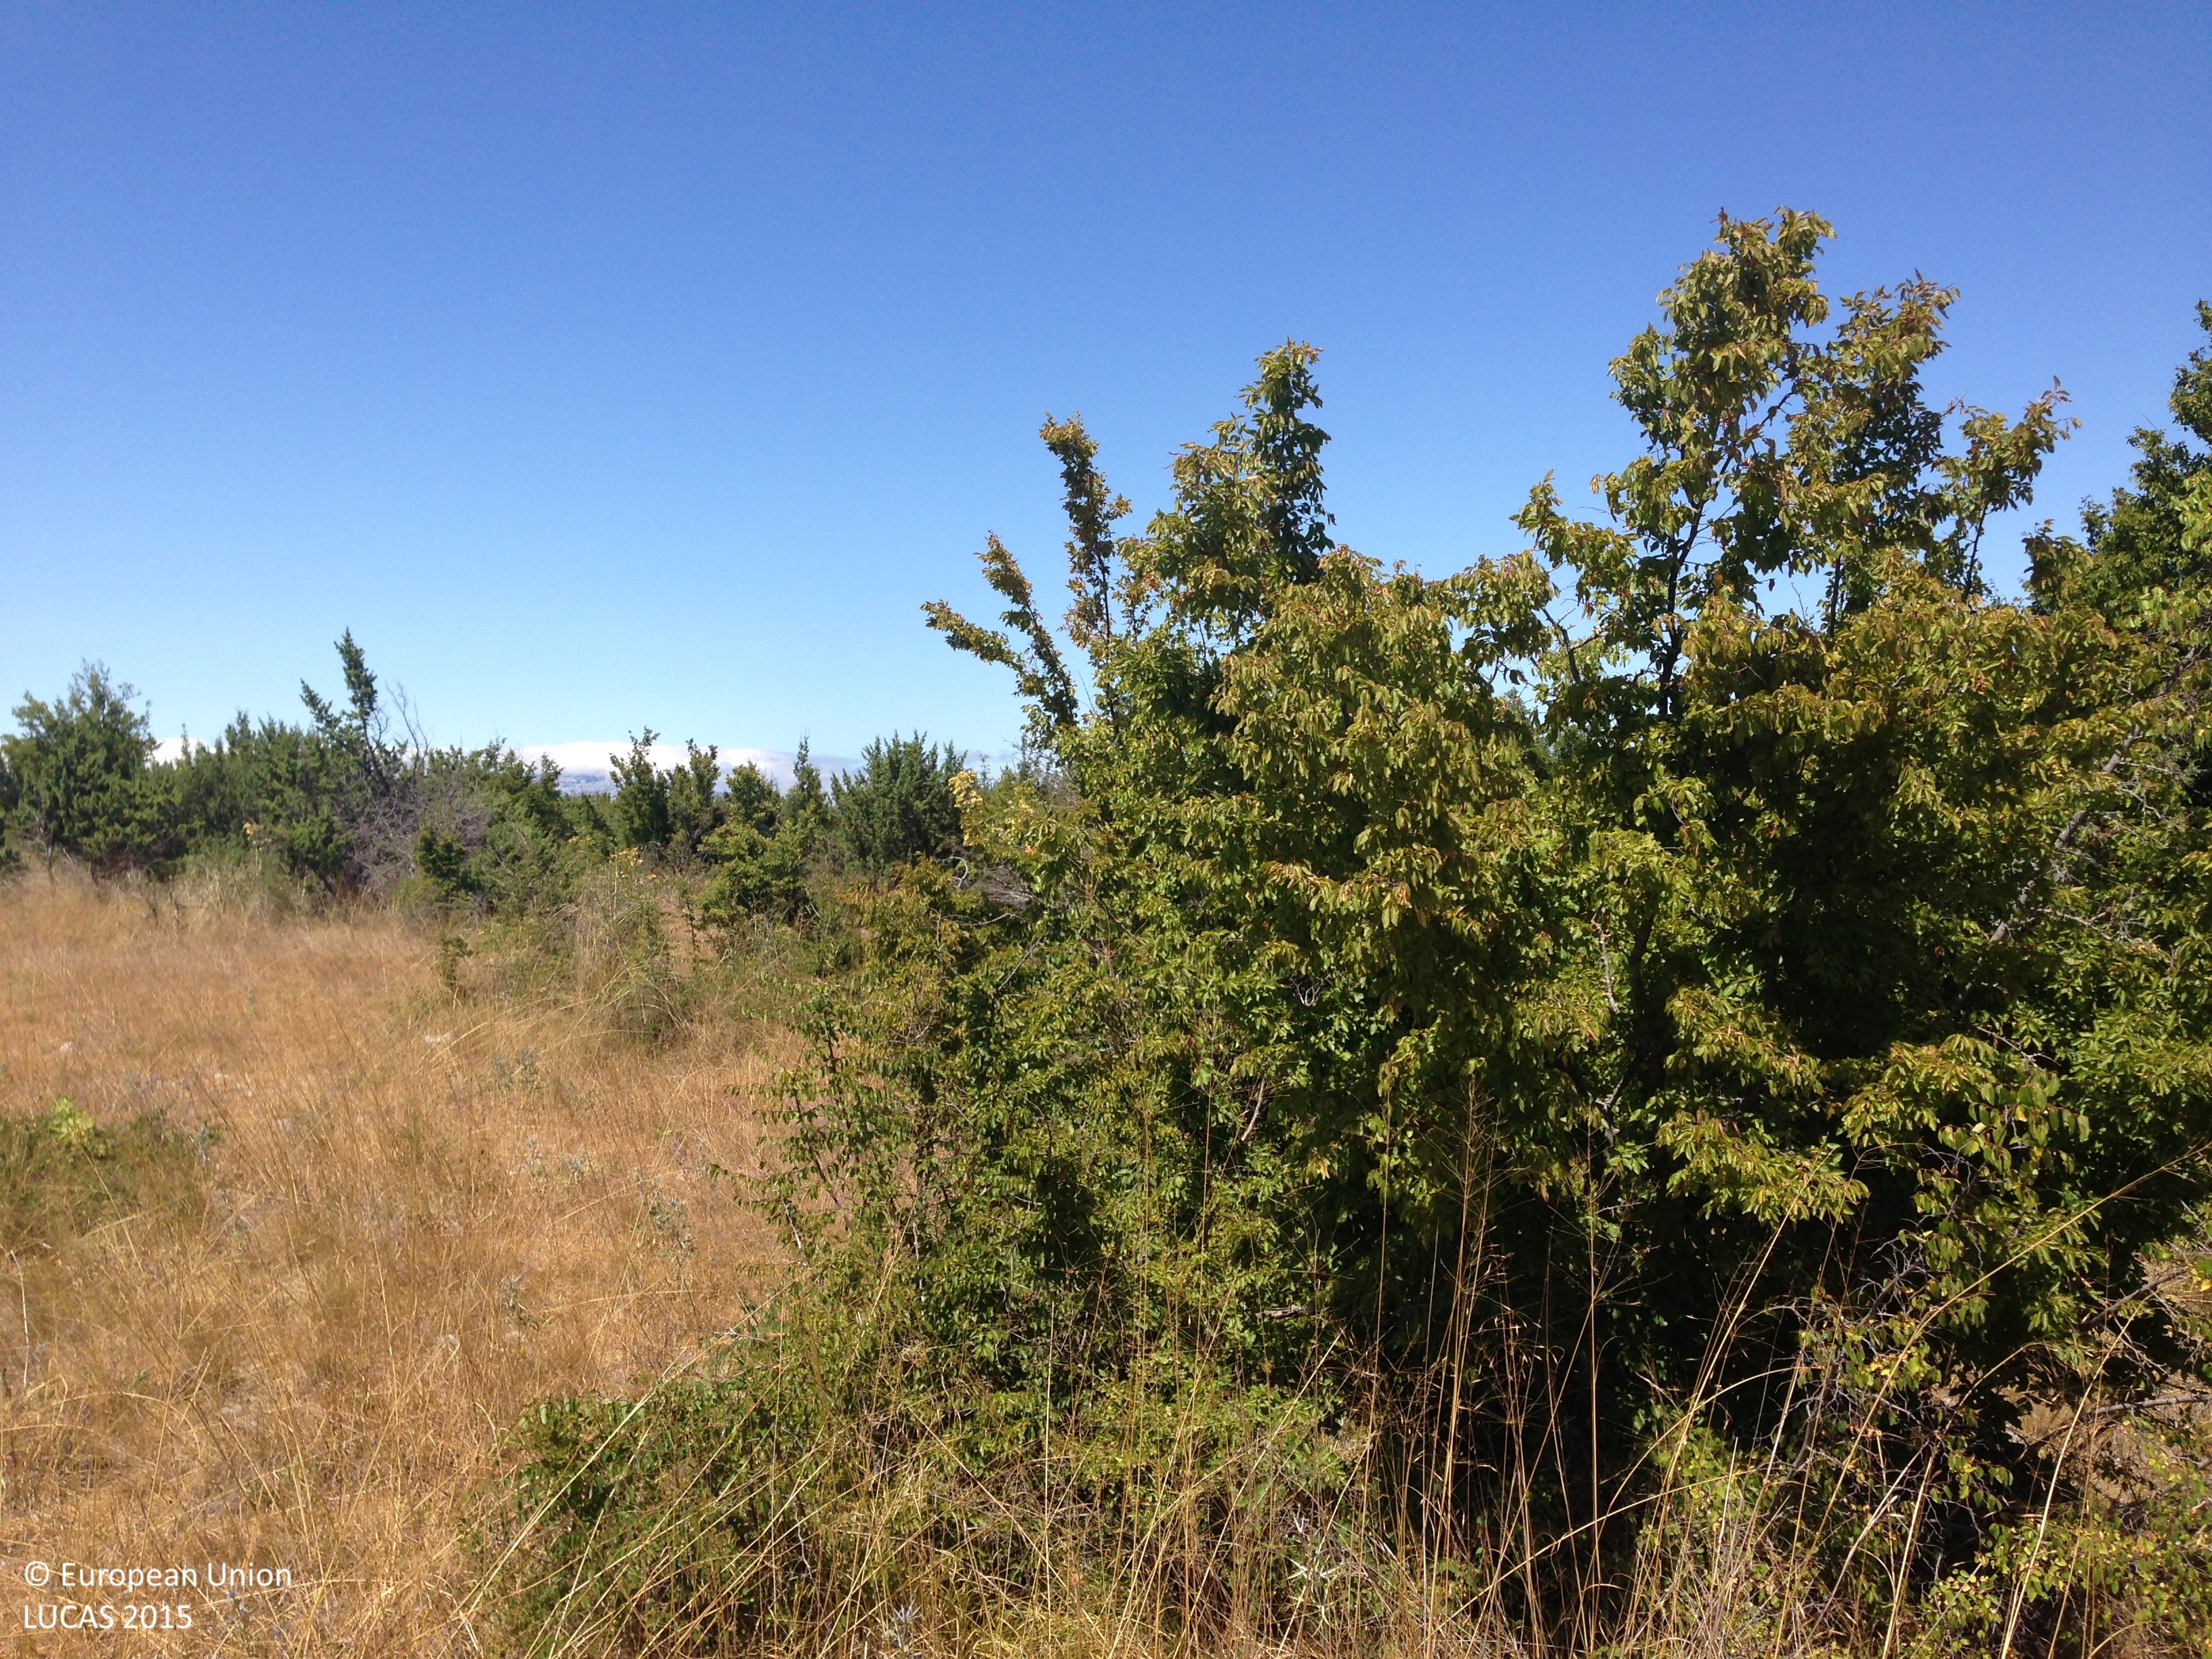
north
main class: Shrubland
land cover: Shrubland with sparse tree cover
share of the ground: > 75 %
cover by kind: shrubs 35 %, herbaceous plants 35 %, consolidated bare surface 15 %, unconsolidated bare surface 10 %, broadleaved forest trees 5 %
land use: Semi-natural and natural areas not in use
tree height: < 5 m
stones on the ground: < 10 %
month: July
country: HR
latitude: 44.0175
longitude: 15.9425
